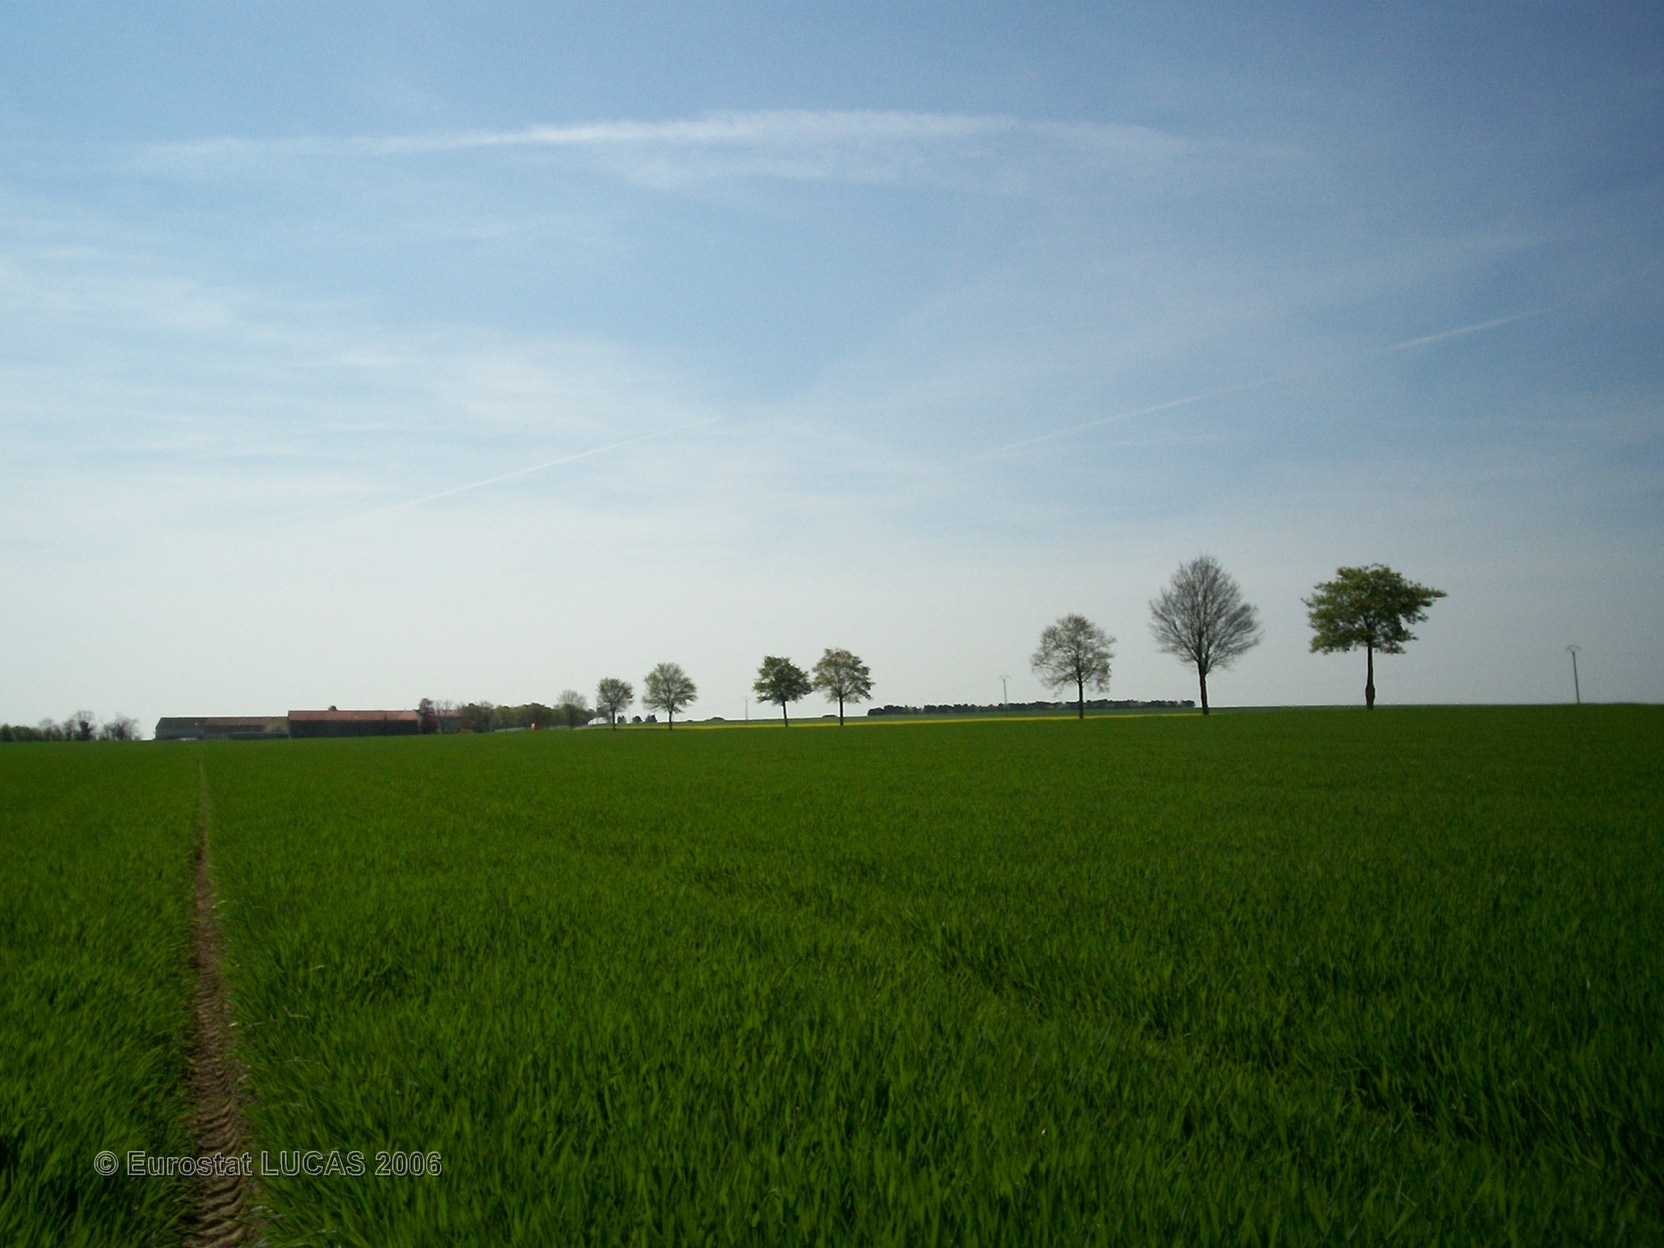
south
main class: Cropland
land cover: Barley
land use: Agriculture (excluding fallow land and kitchen gardens)
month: May
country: FR
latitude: 48.8758
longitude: 4.4199
